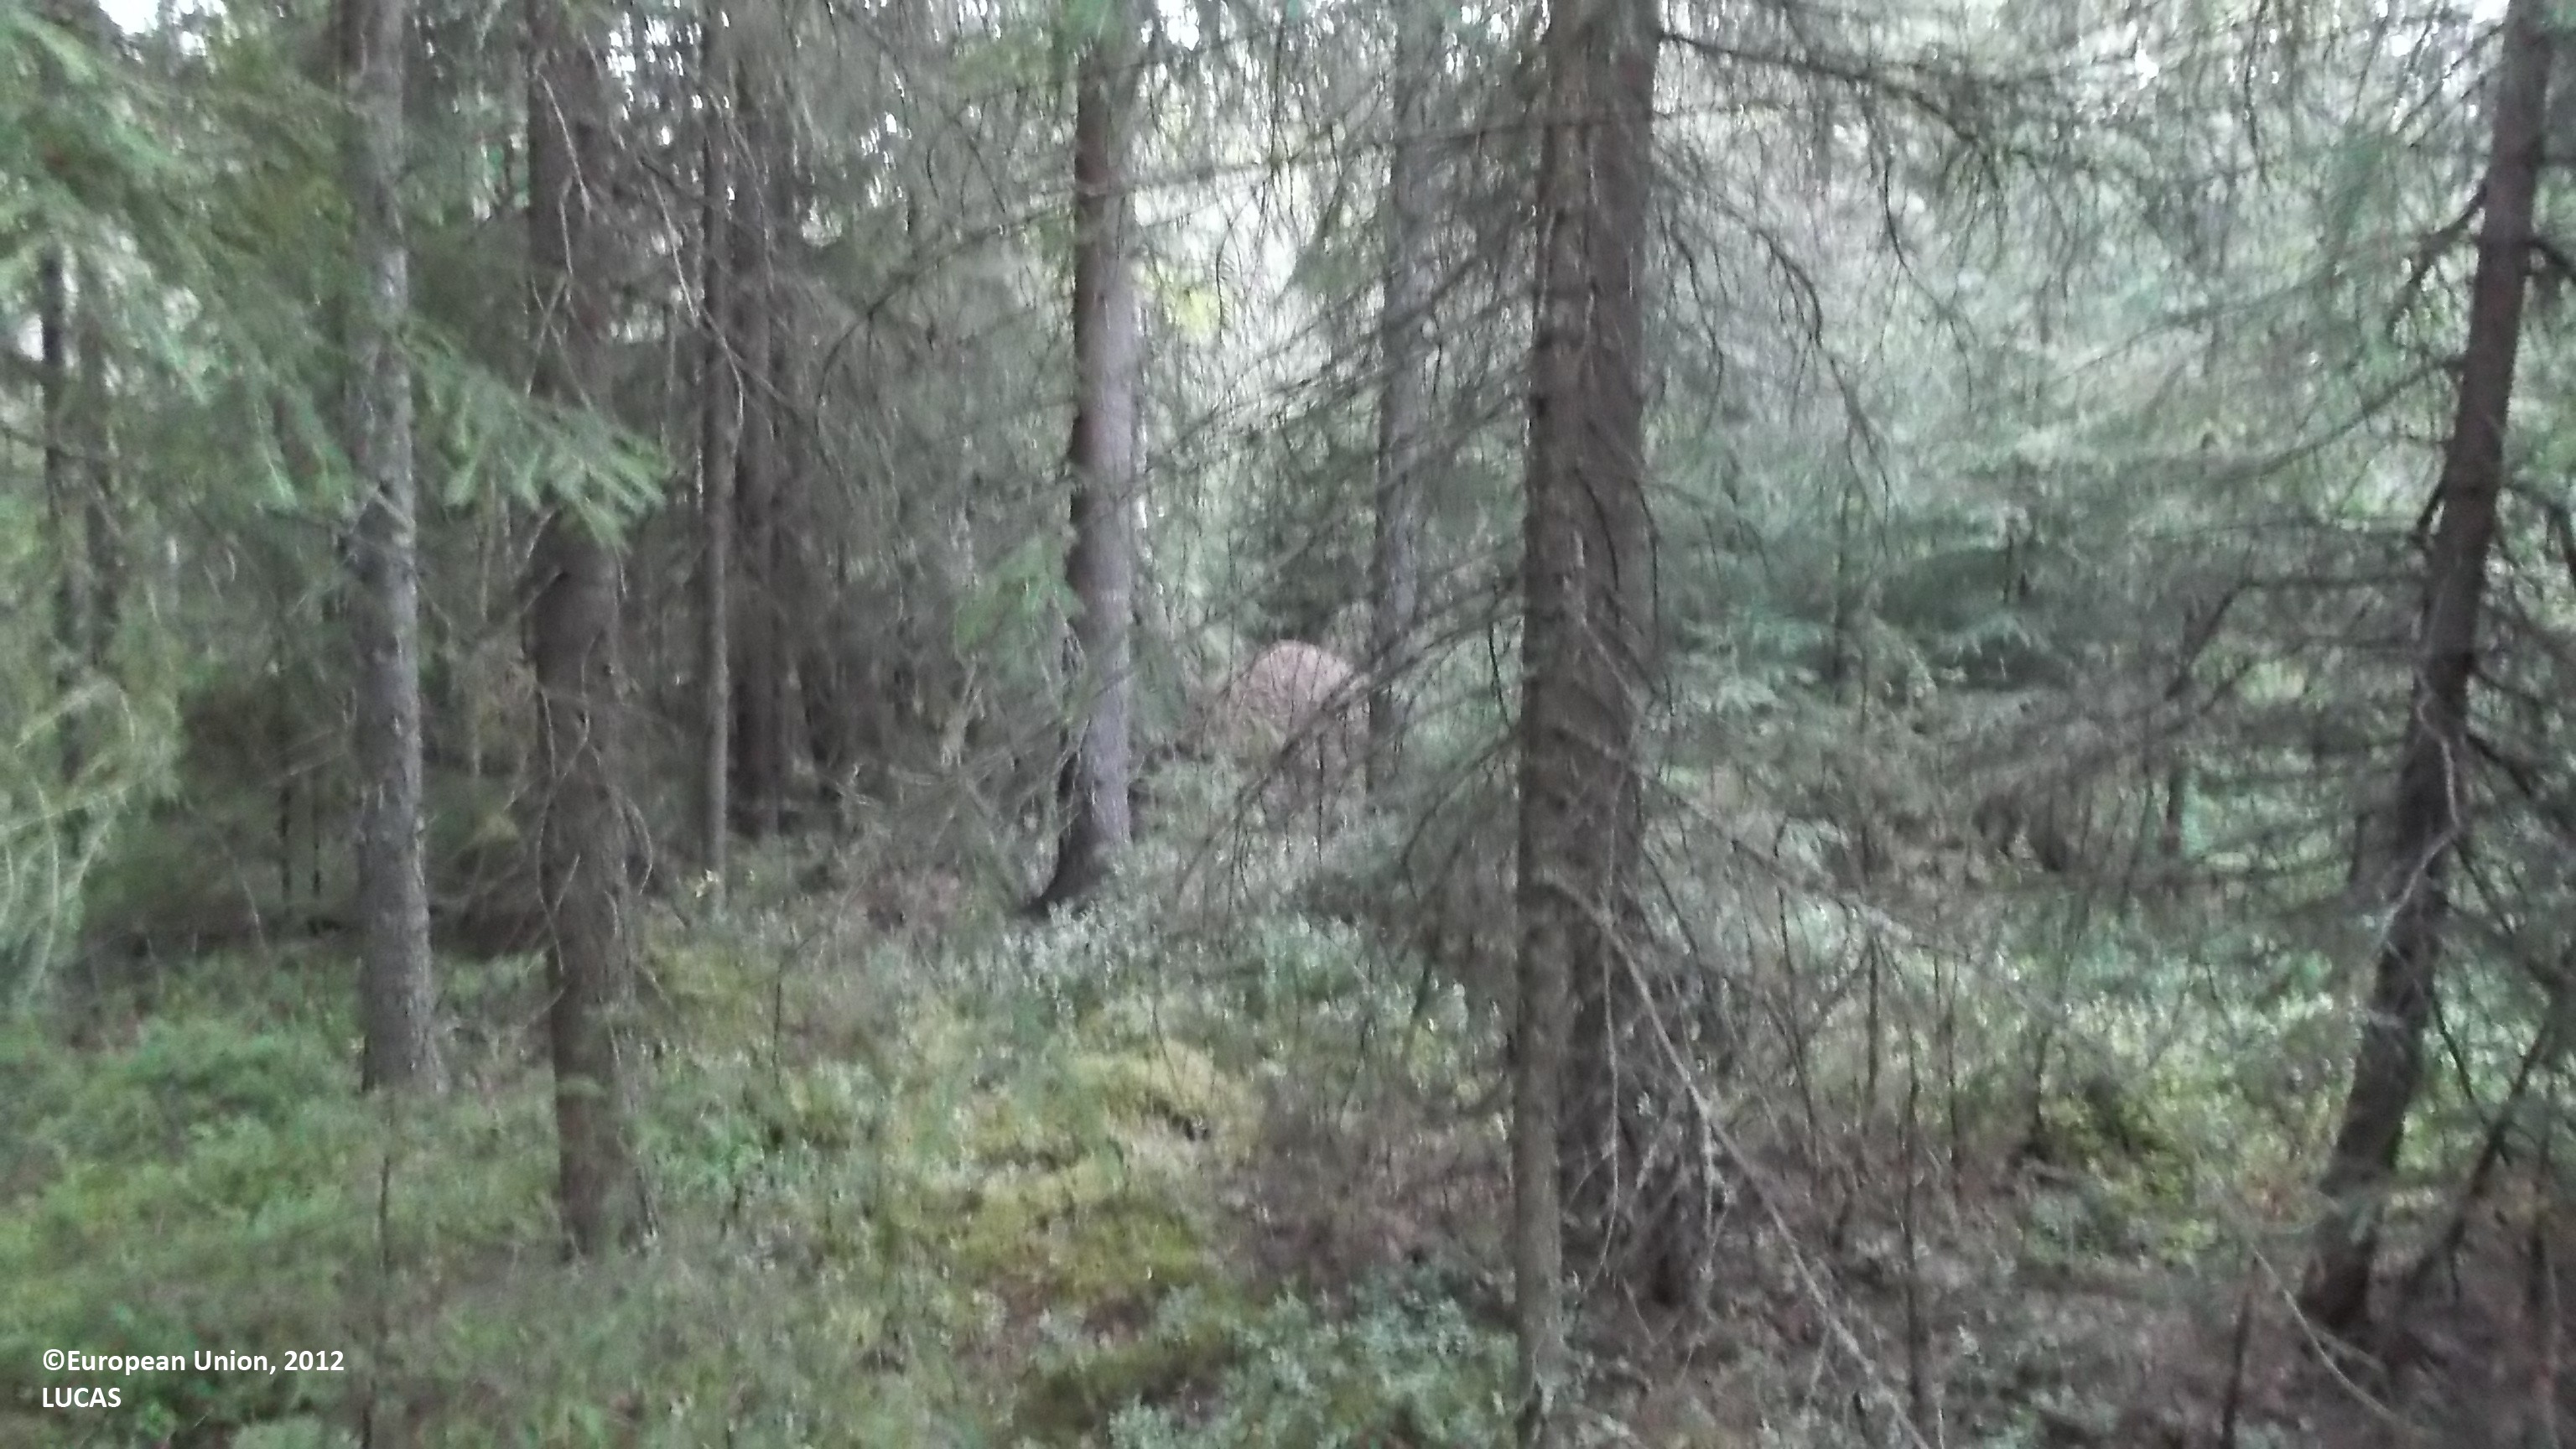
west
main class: Woodland
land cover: Spruce dominated mixed woodland
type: boreal forest
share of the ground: > 75 %
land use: Forestry
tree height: > 5 m
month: July
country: FI
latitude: 63.5938
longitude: 23.7497
